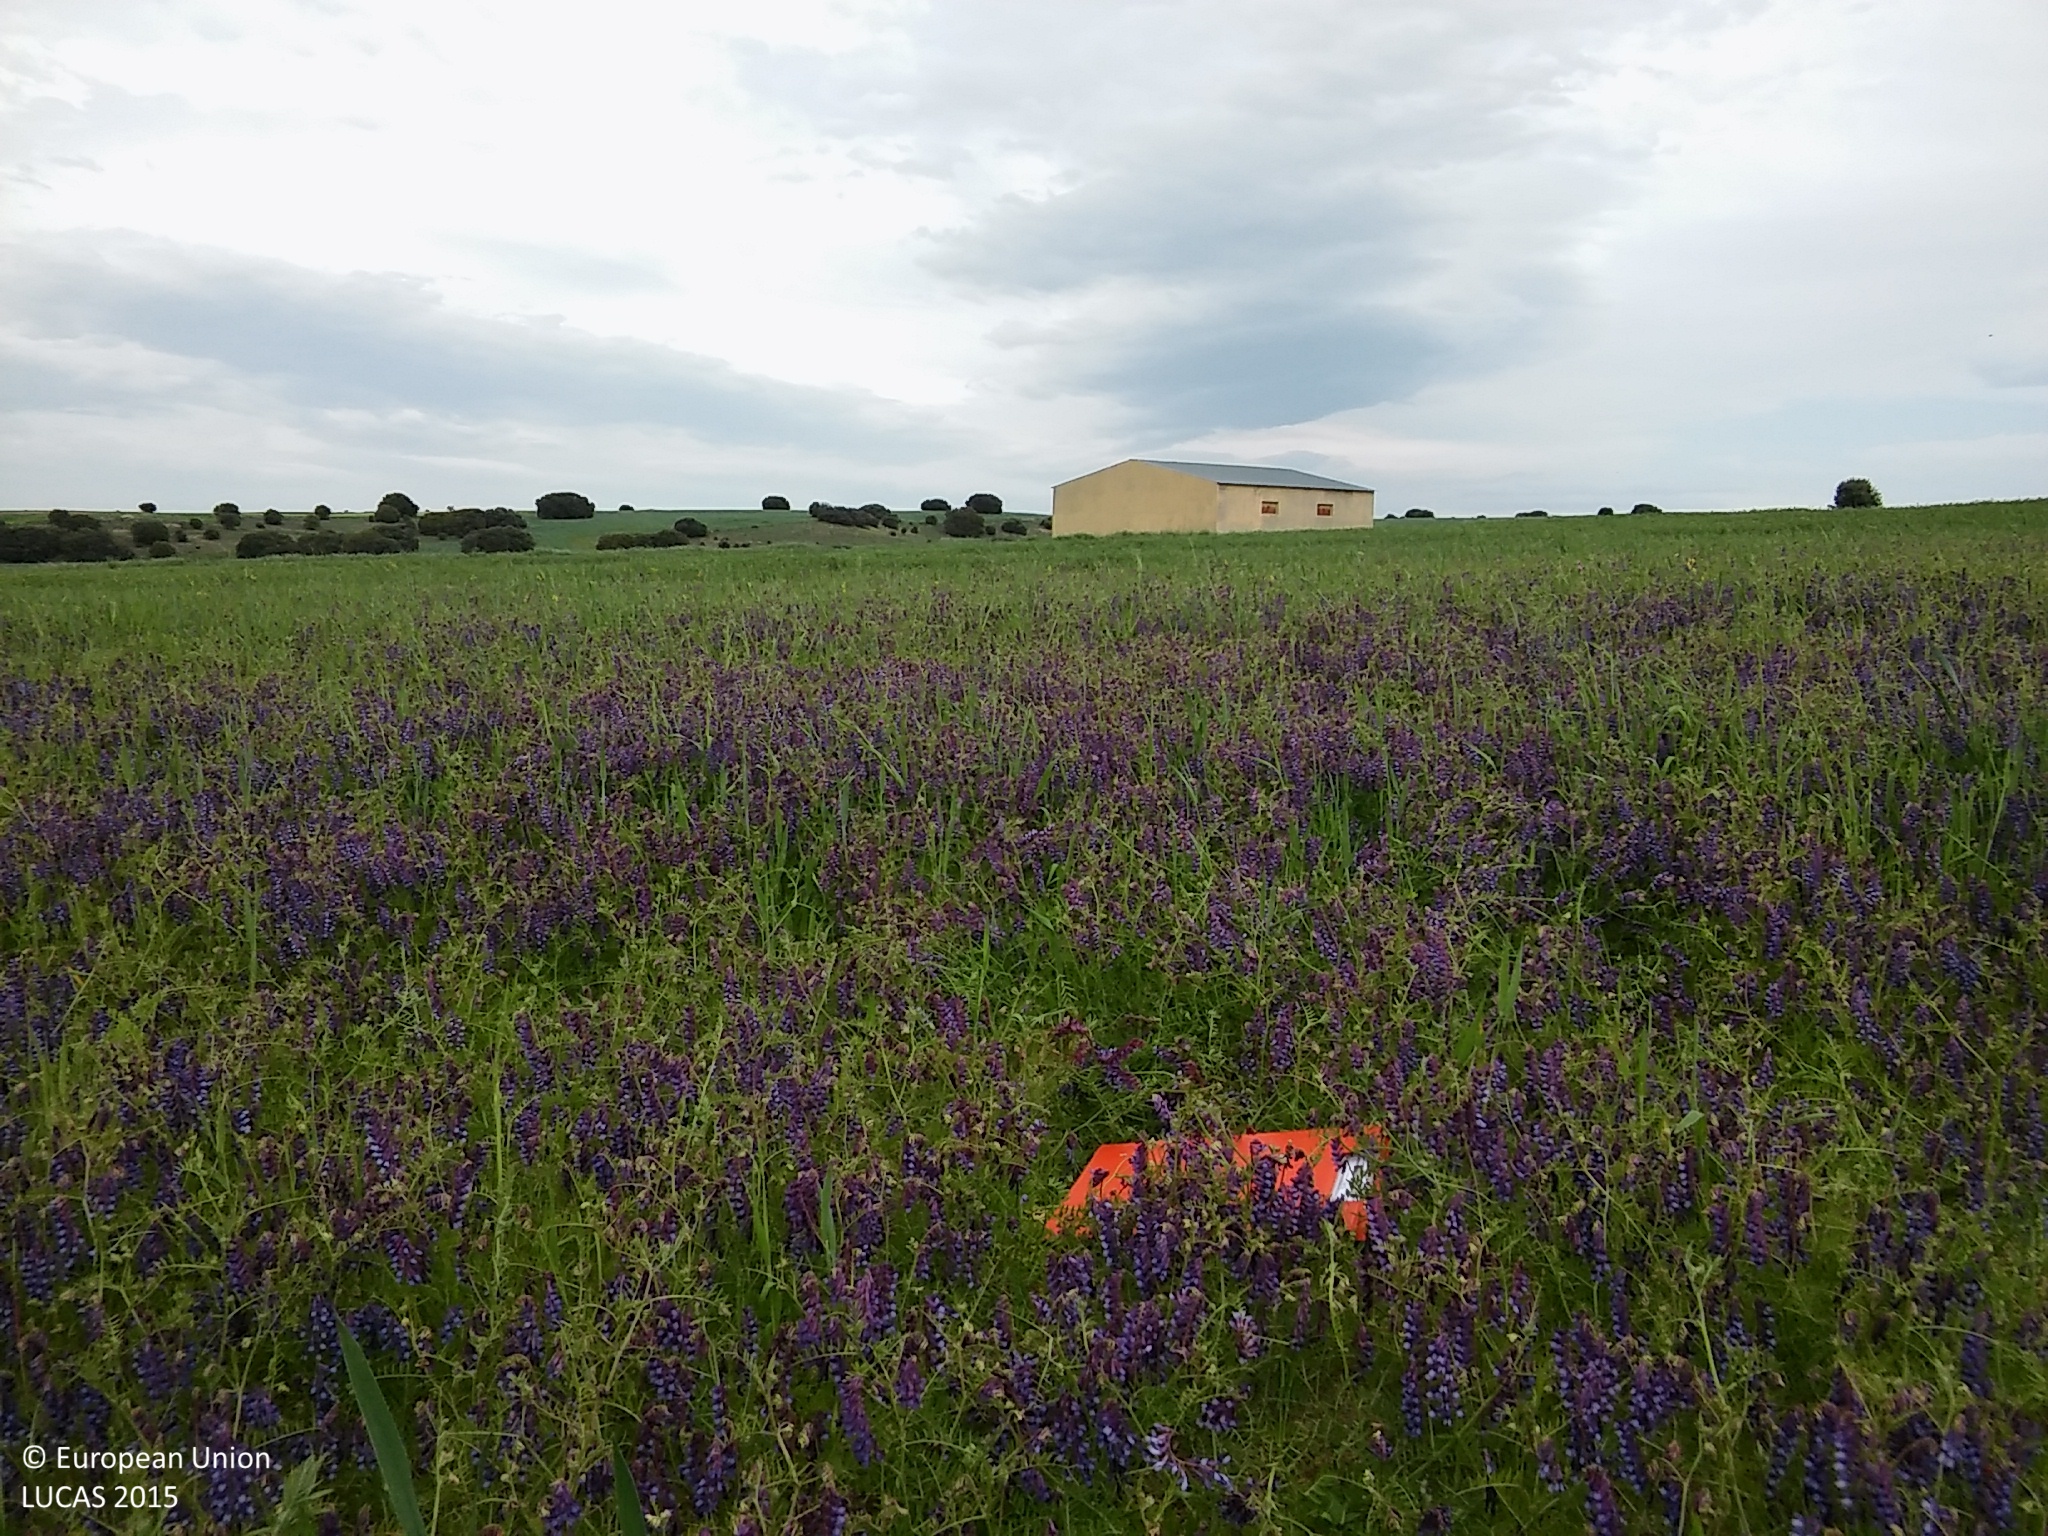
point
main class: Cropland
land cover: Dry pulses
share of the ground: > 75 %
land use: Agriculture (excluding fallow land and kitchen gardens)
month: May
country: ES
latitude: 41.0606
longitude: -4.0805
